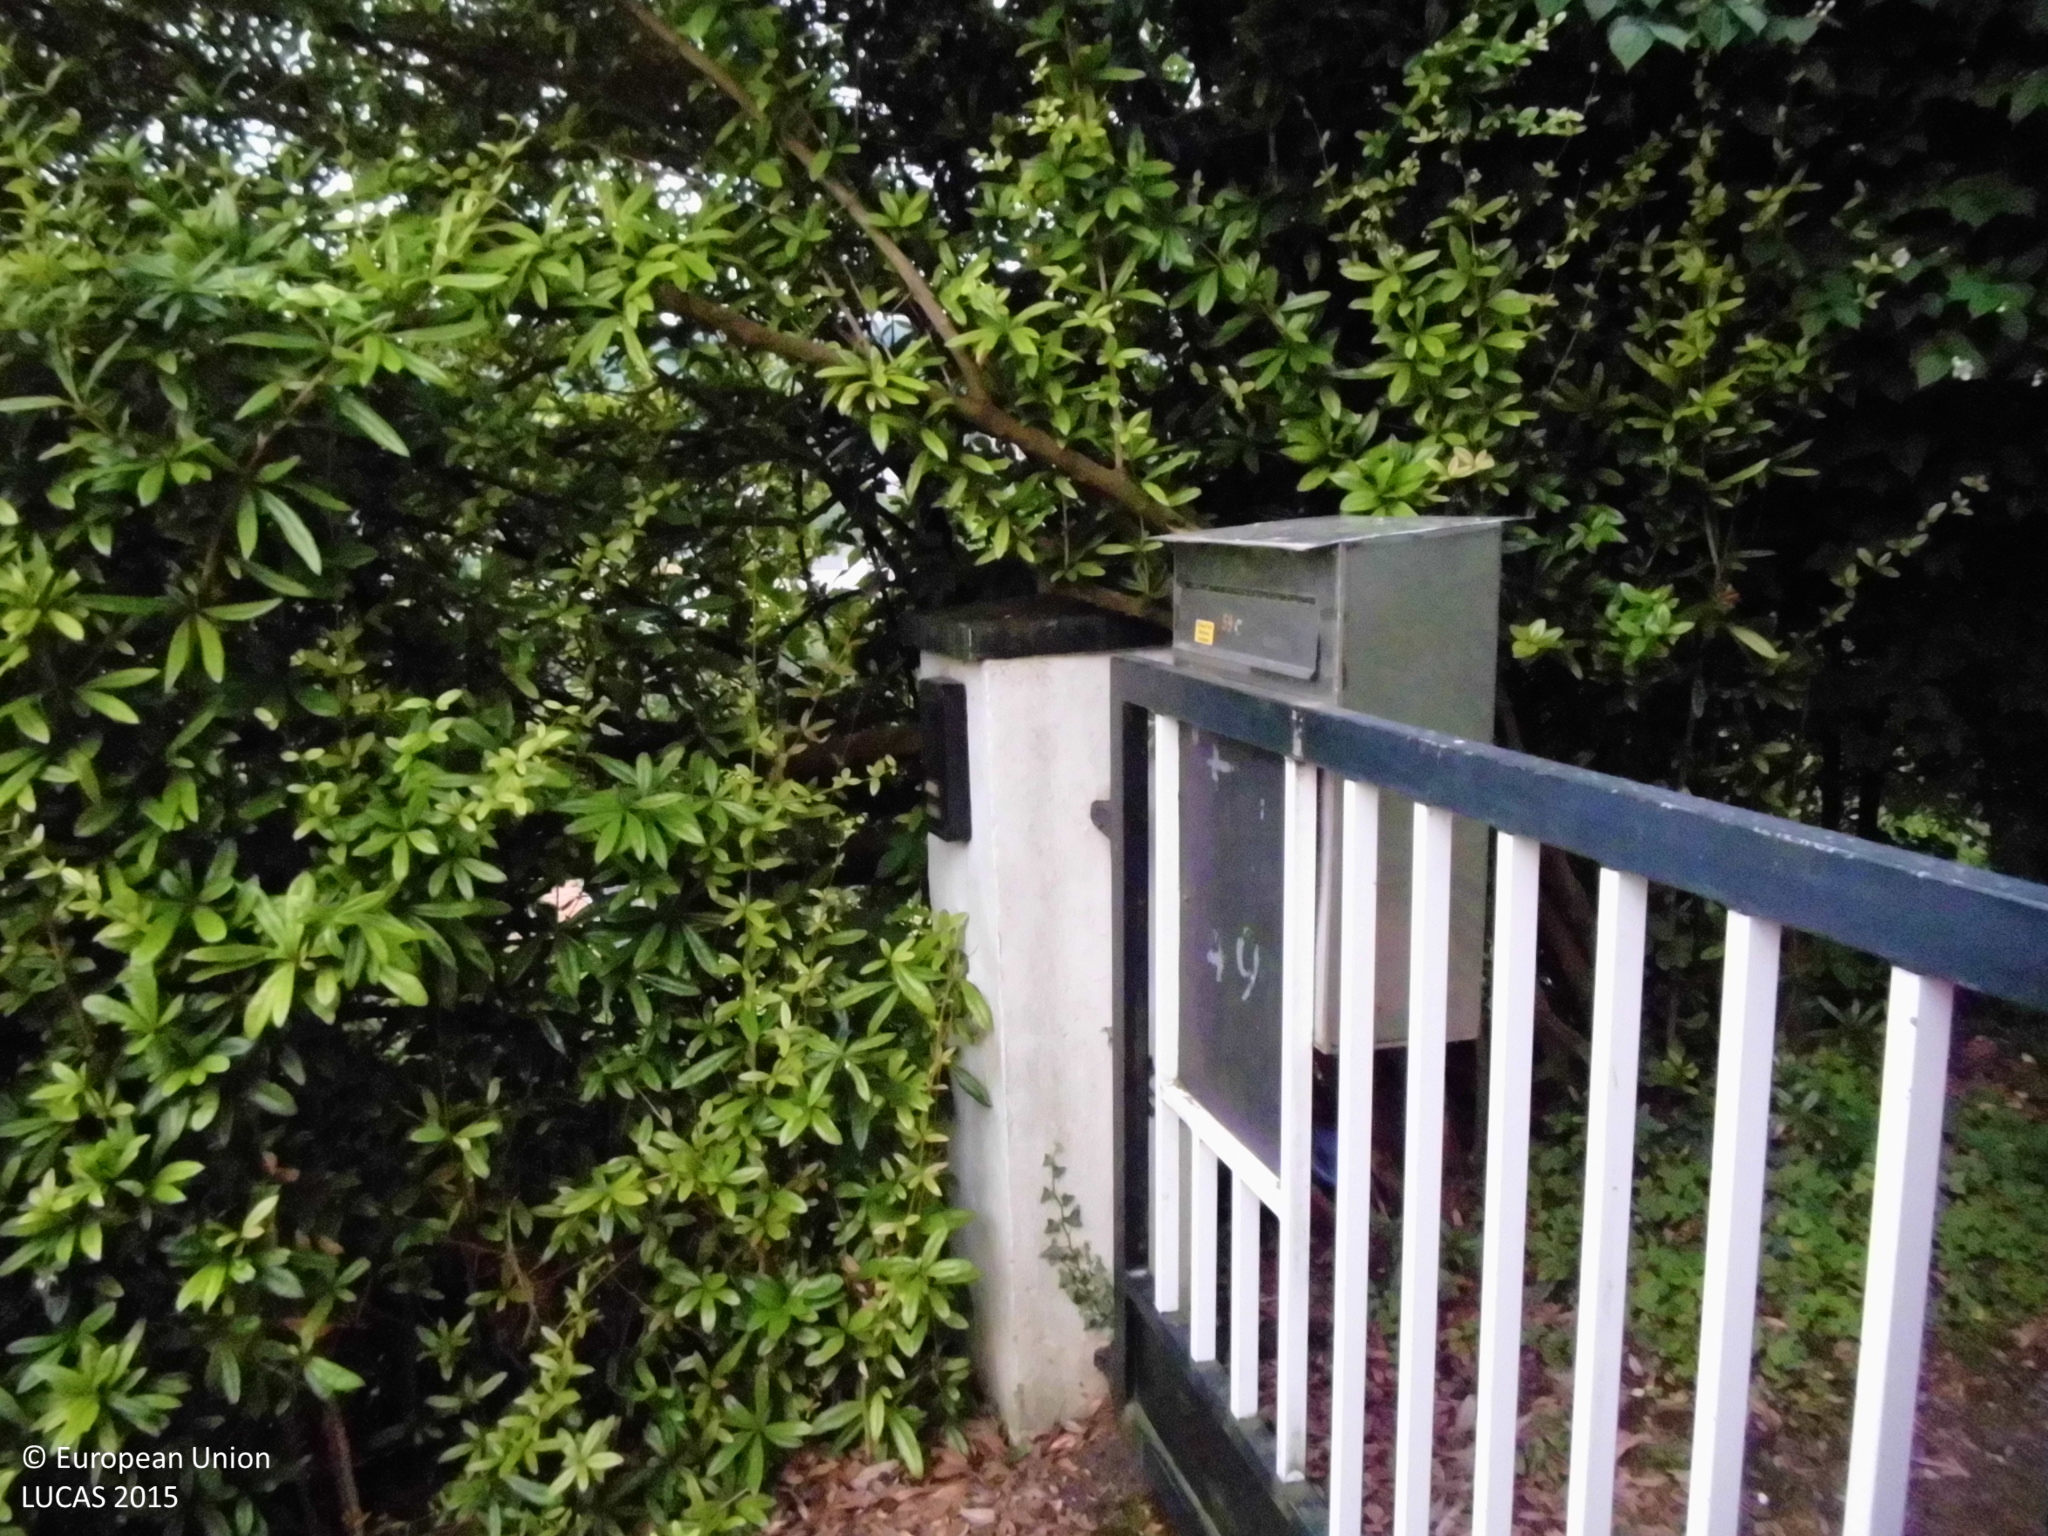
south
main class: Woodland
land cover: Other coniferous woodland
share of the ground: > 75 %
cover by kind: coniferous forest trees 70 %, broadleaved forest trees 20 %, shrubs 5 %, herbaceous plants 5 %
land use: Residential
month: June
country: DE
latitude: 51.3438
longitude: 7.4879
